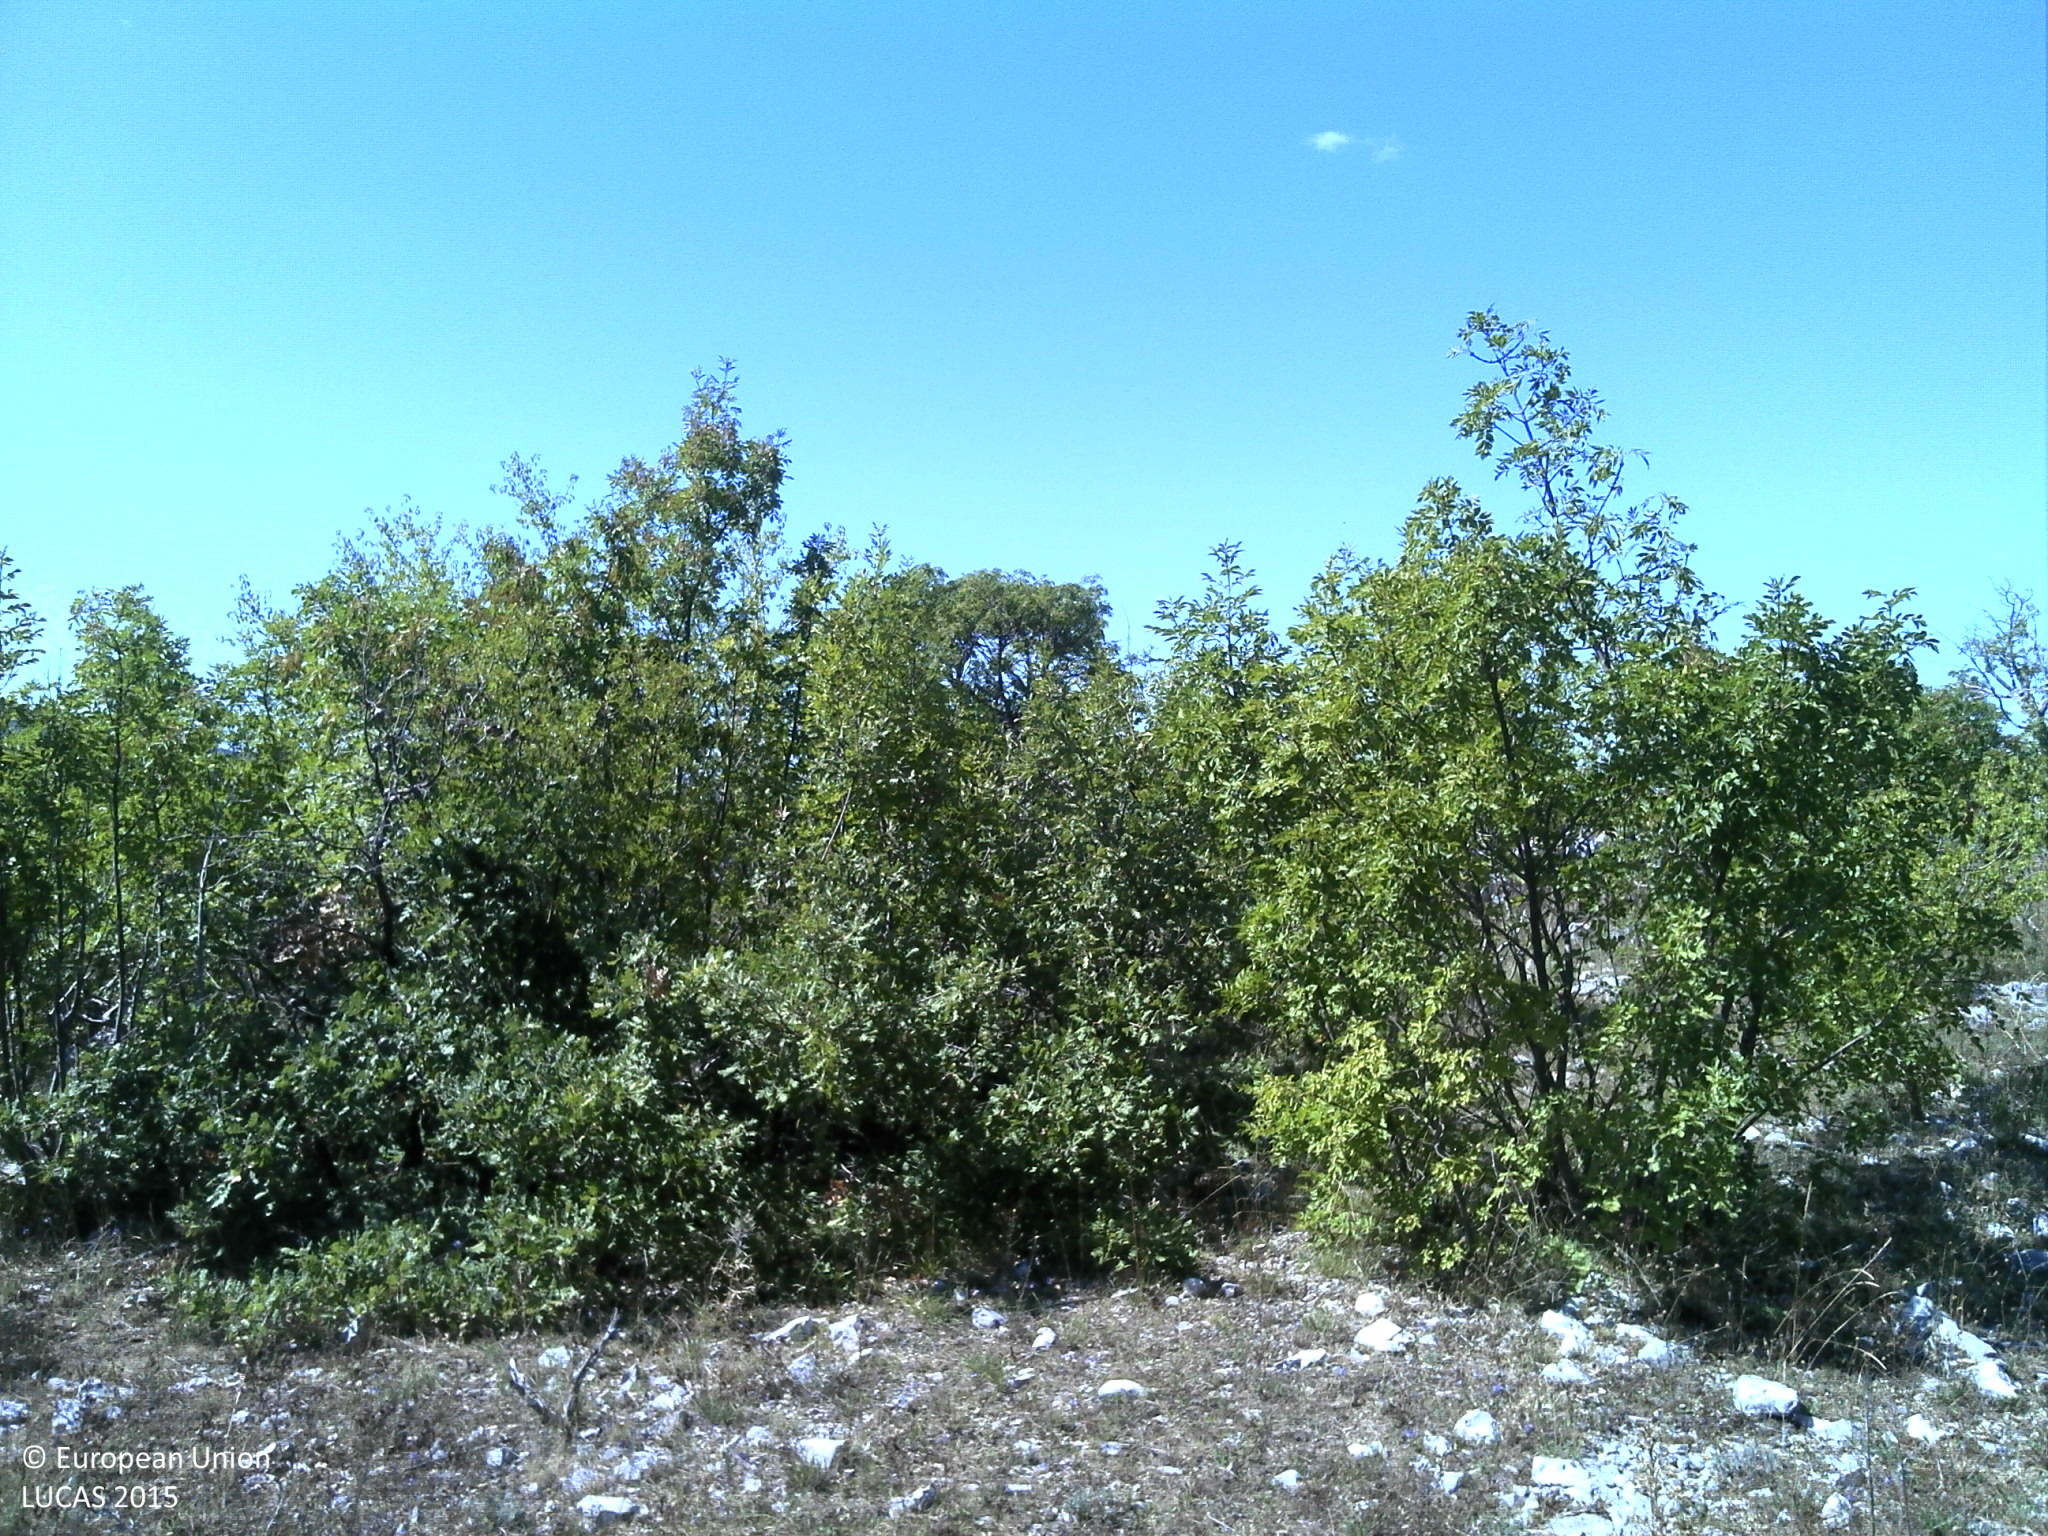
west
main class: Shrubland
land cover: Shrubland with sparse tree cover
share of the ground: 25 - 50 %
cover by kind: herbaceous plants 40 %, shrubs 35 %, consolidated bare surface 10 %, unconsolidated bare surface 10 %, broadleaved forest trees 5 %
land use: Semi-natural and natural areas not in use
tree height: < 5 m
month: September
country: HR
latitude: 43.5820
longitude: 16.2697
